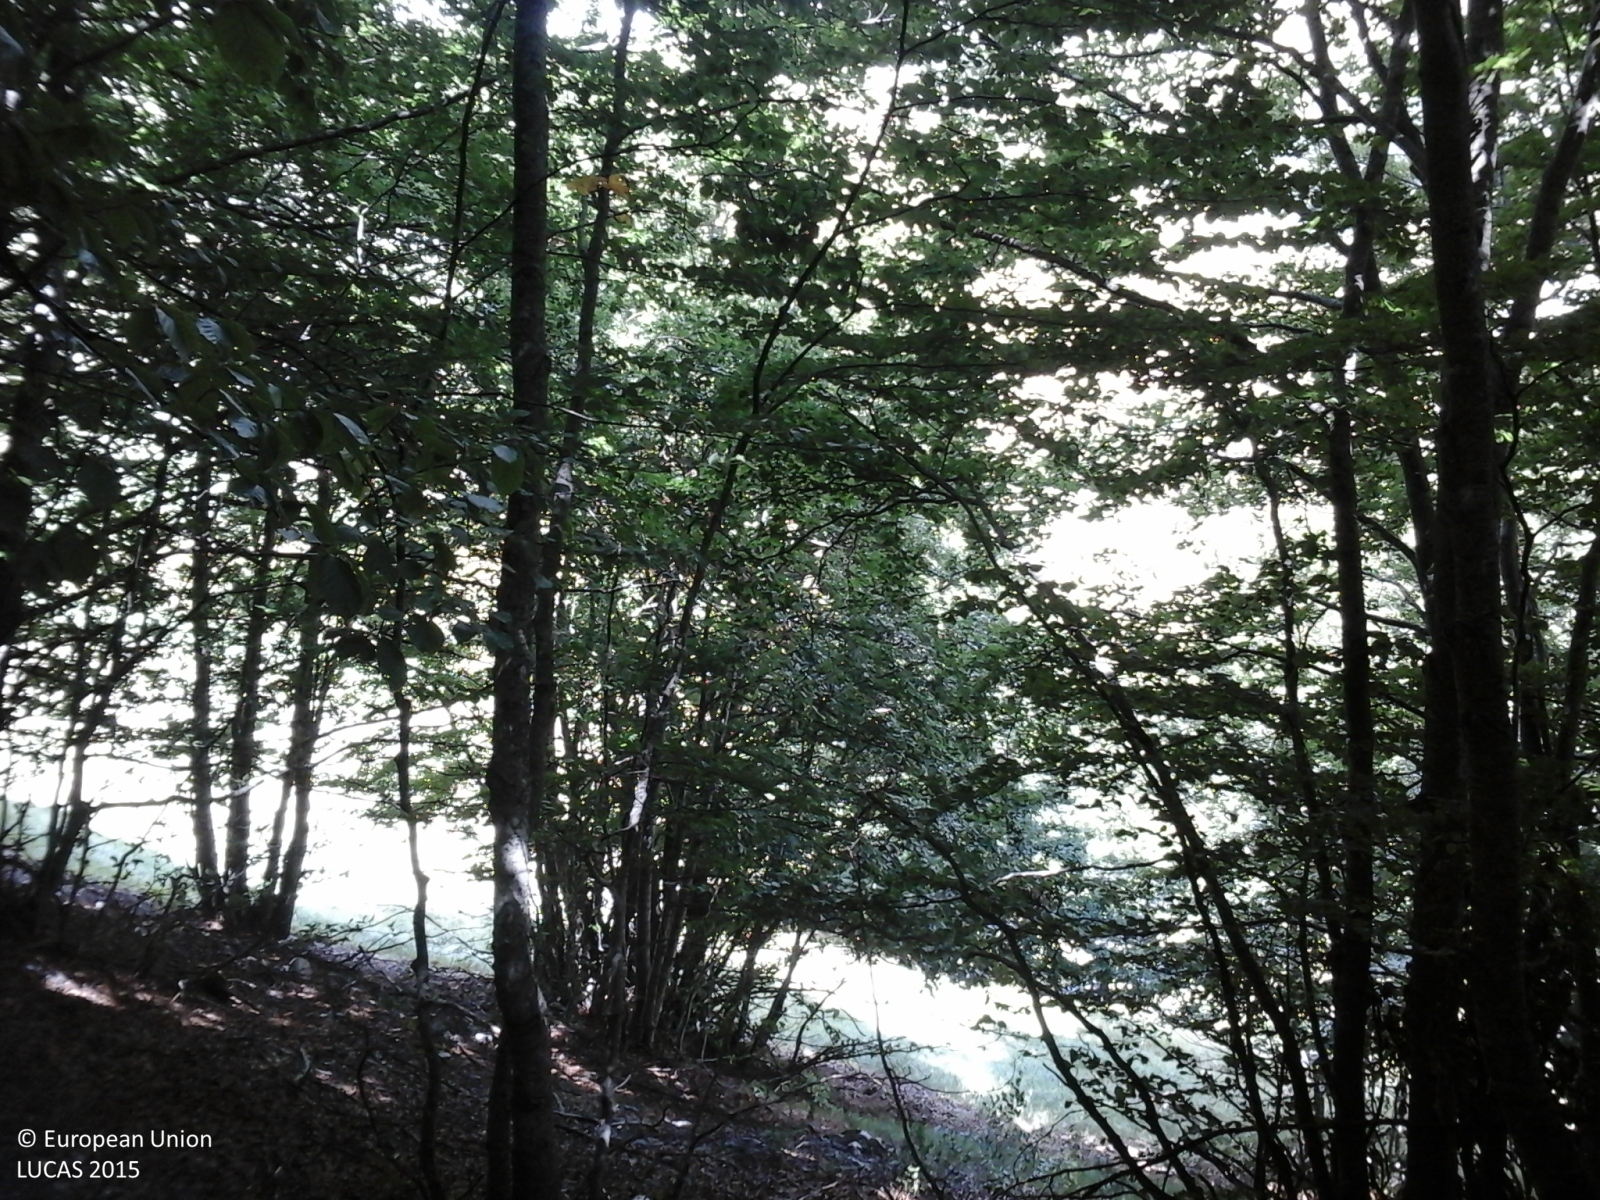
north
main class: Woodland
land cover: Broadleaved woodland
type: mountainous beech forest
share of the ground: > 75 %
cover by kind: broadleaved forest trees 100 %
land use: Forestry
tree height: > 5 m
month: August
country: IT
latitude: 42.8562
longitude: 13.2093
